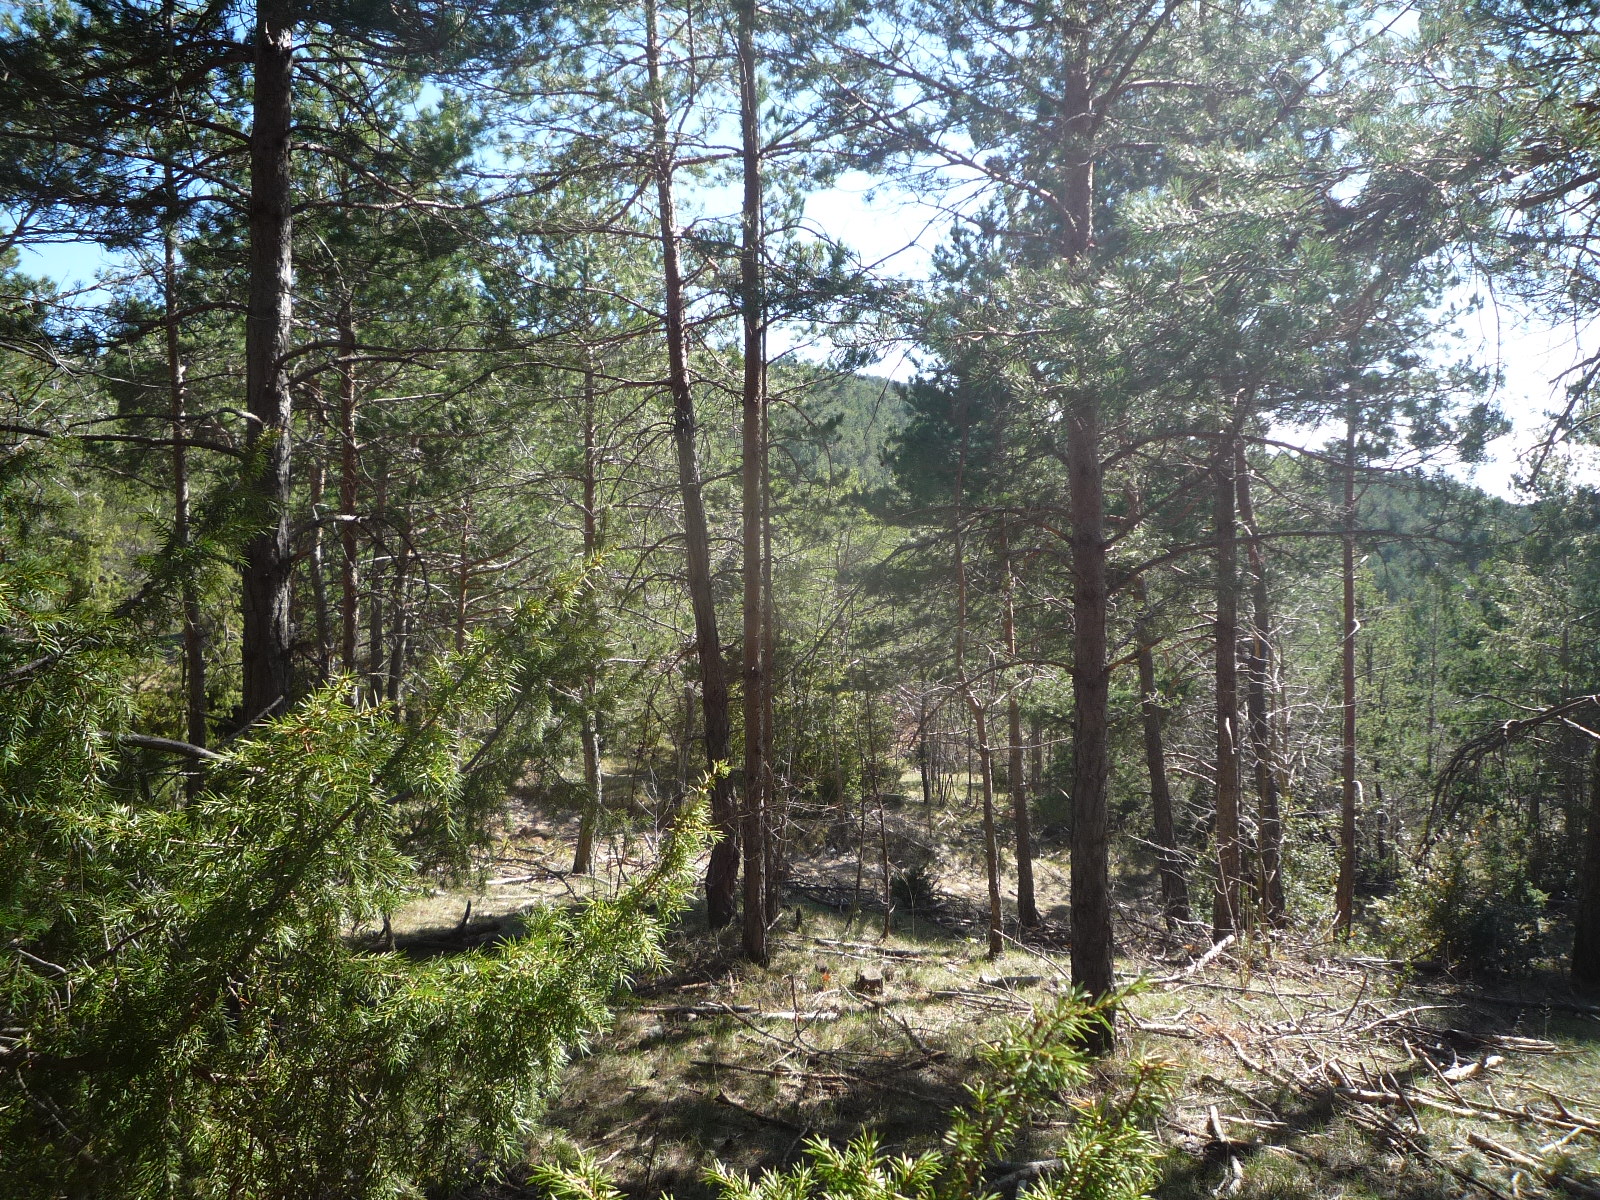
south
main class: Woodland
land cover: Pine dominated coniferous woodland
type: coniferous forest of the mediterranean region
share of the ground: > 75 %
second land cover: Spontaneously vegetated surfaces
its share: 25 - 50 %
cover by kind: coniferous forest trees 75 %, herbaceous plants 25 %
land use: Forestry
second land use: Agriculture (excluding fallow land and kitchen gardens)
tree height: > 5 m
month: March
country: ES
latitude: 42.0896
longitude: 1.6341
